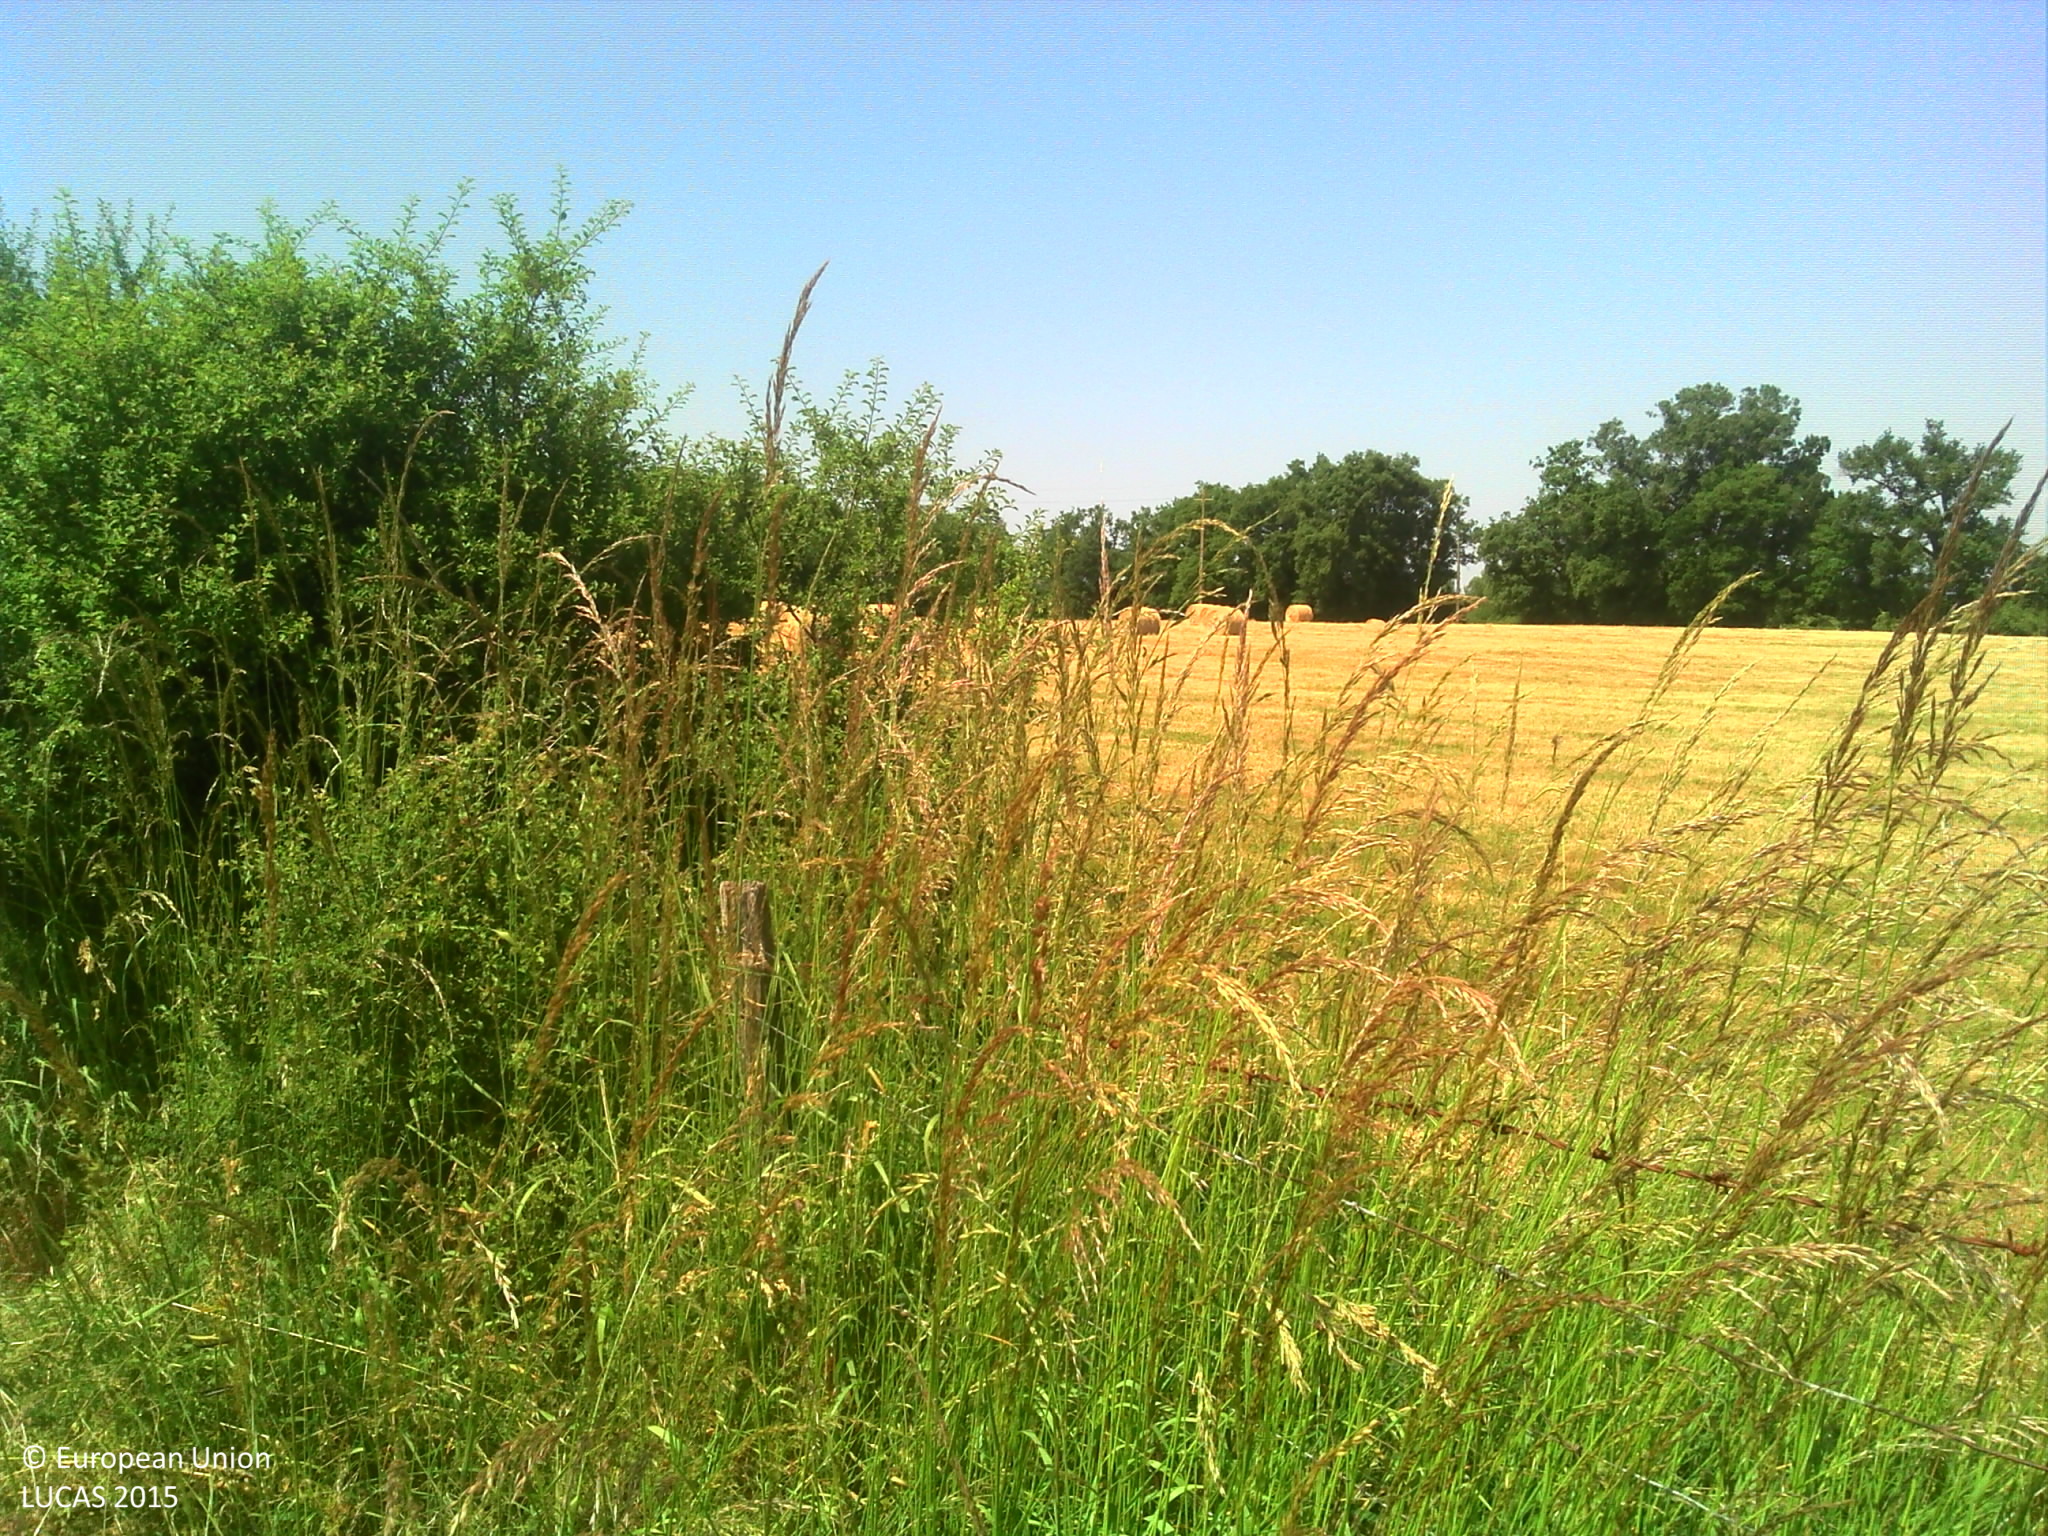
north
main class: Grassland
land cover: Grassland without tree/shrub cover
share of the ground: > 75 %
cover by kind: herbaceous plants 100 %
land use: Agriculture (excluding fallow land and kitchen gardens)
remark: Harvested field
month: June
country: FR
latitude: 43.5632
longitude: 2.1441
